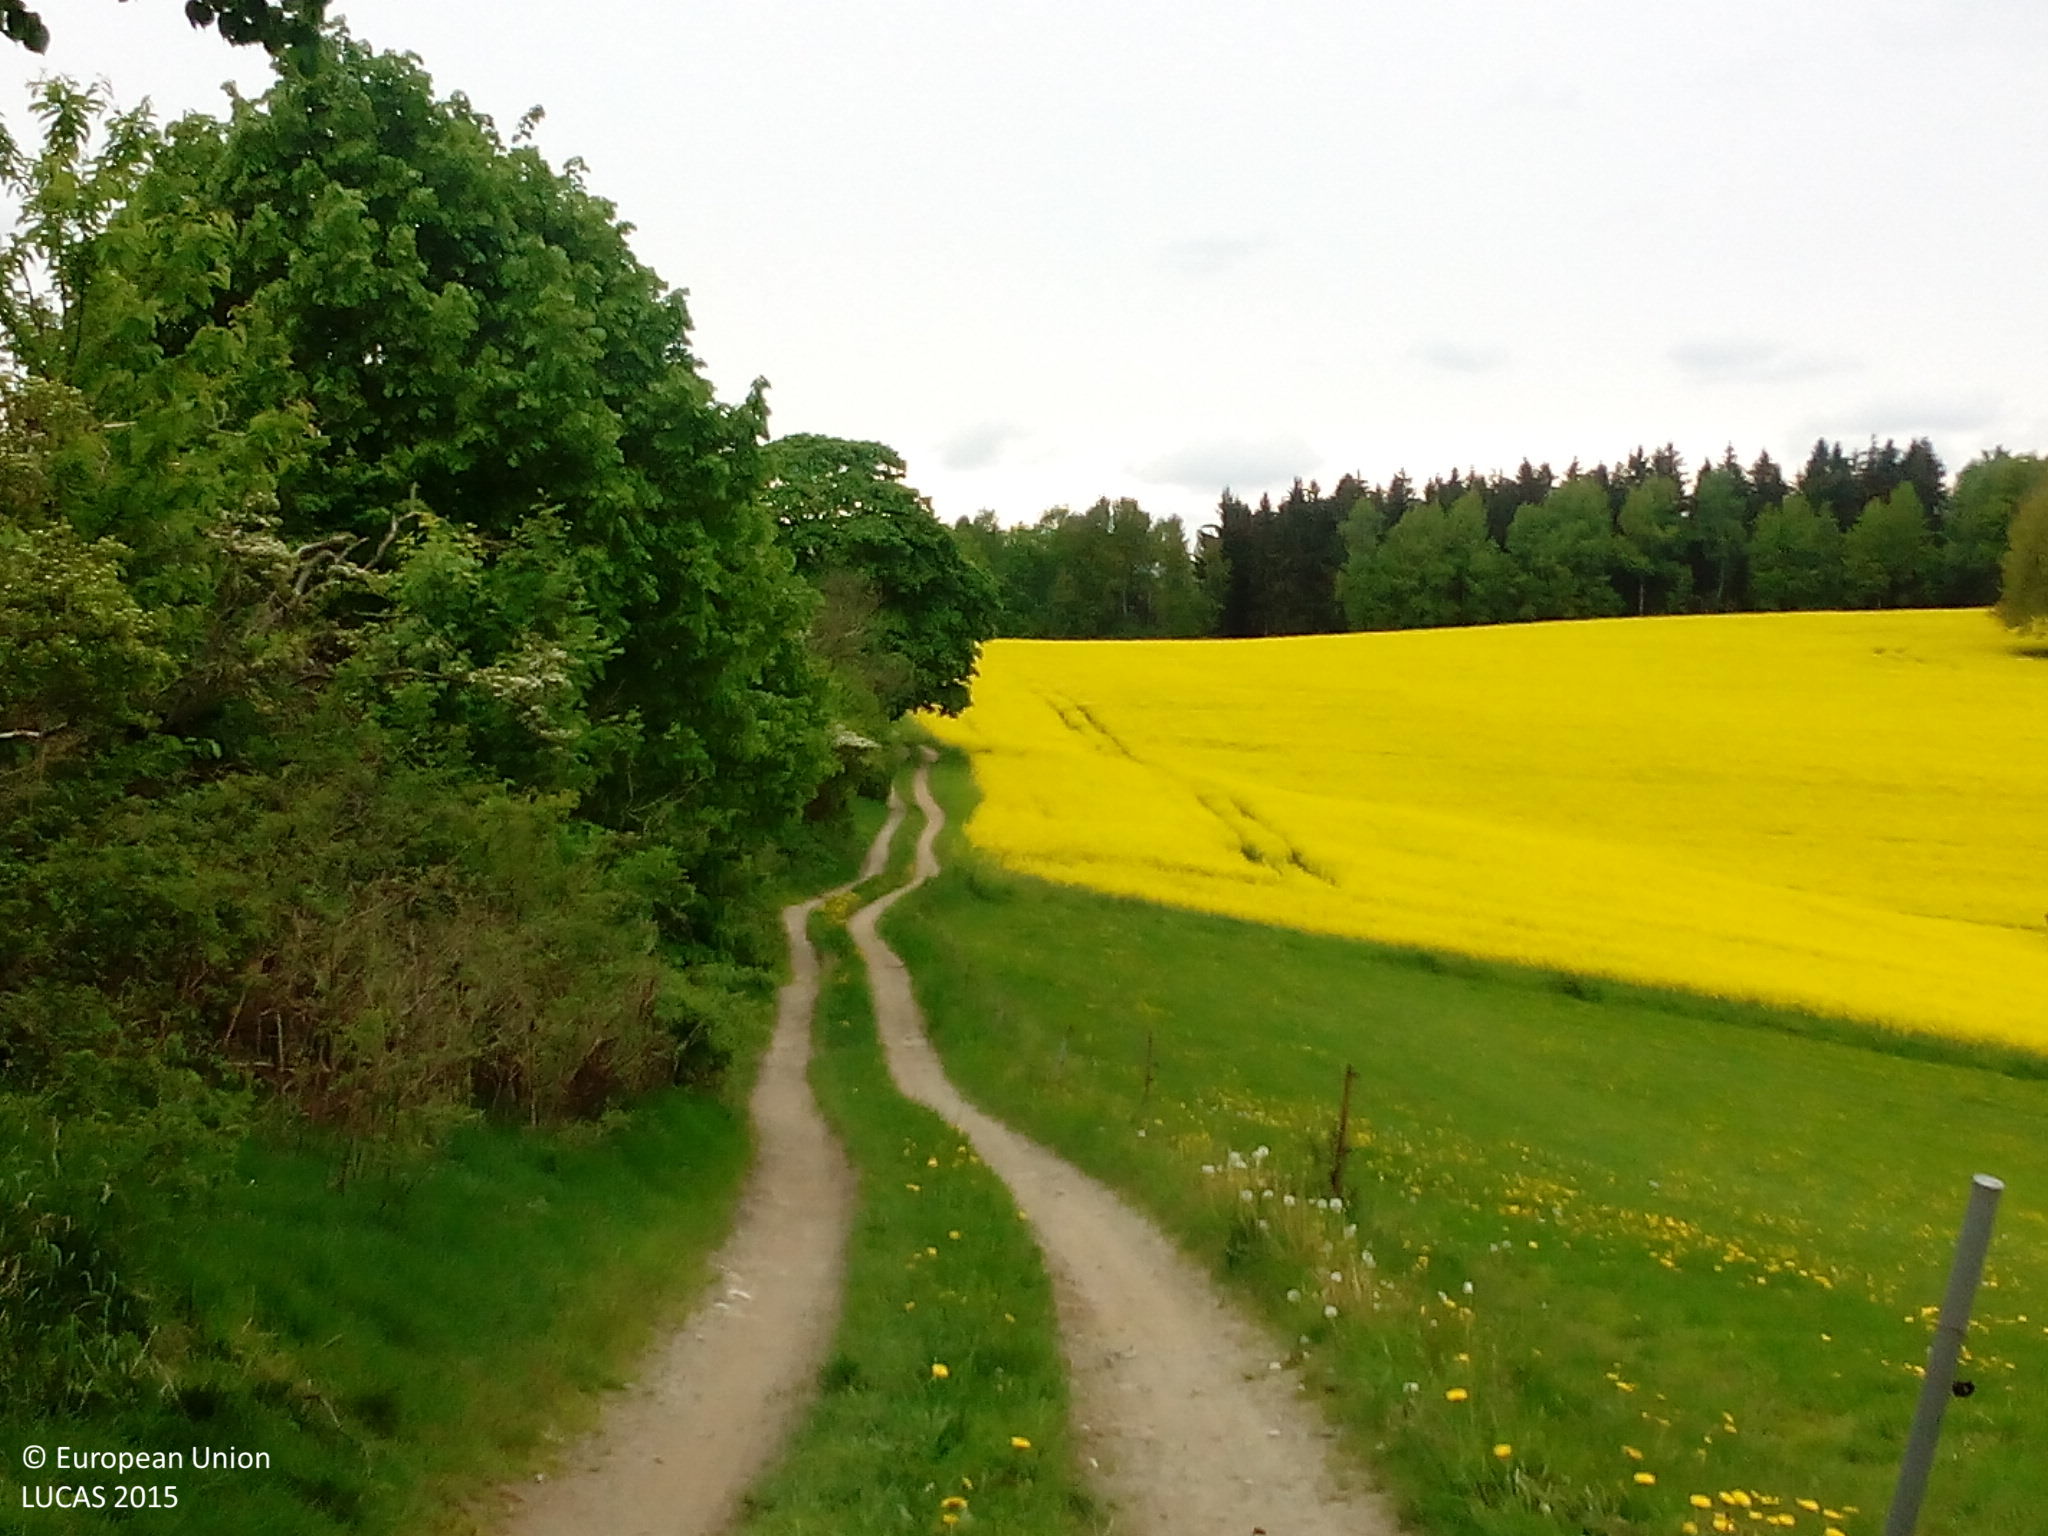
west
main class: Grassland
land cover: Grassland without tree/shrub cover
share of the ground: > 75 %
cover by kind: herbaceous plants 100 %
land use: Agriculture (excluding fallow land and kitchen gardens)
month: May
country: DE
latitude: 50.6670
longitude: 12.9853
